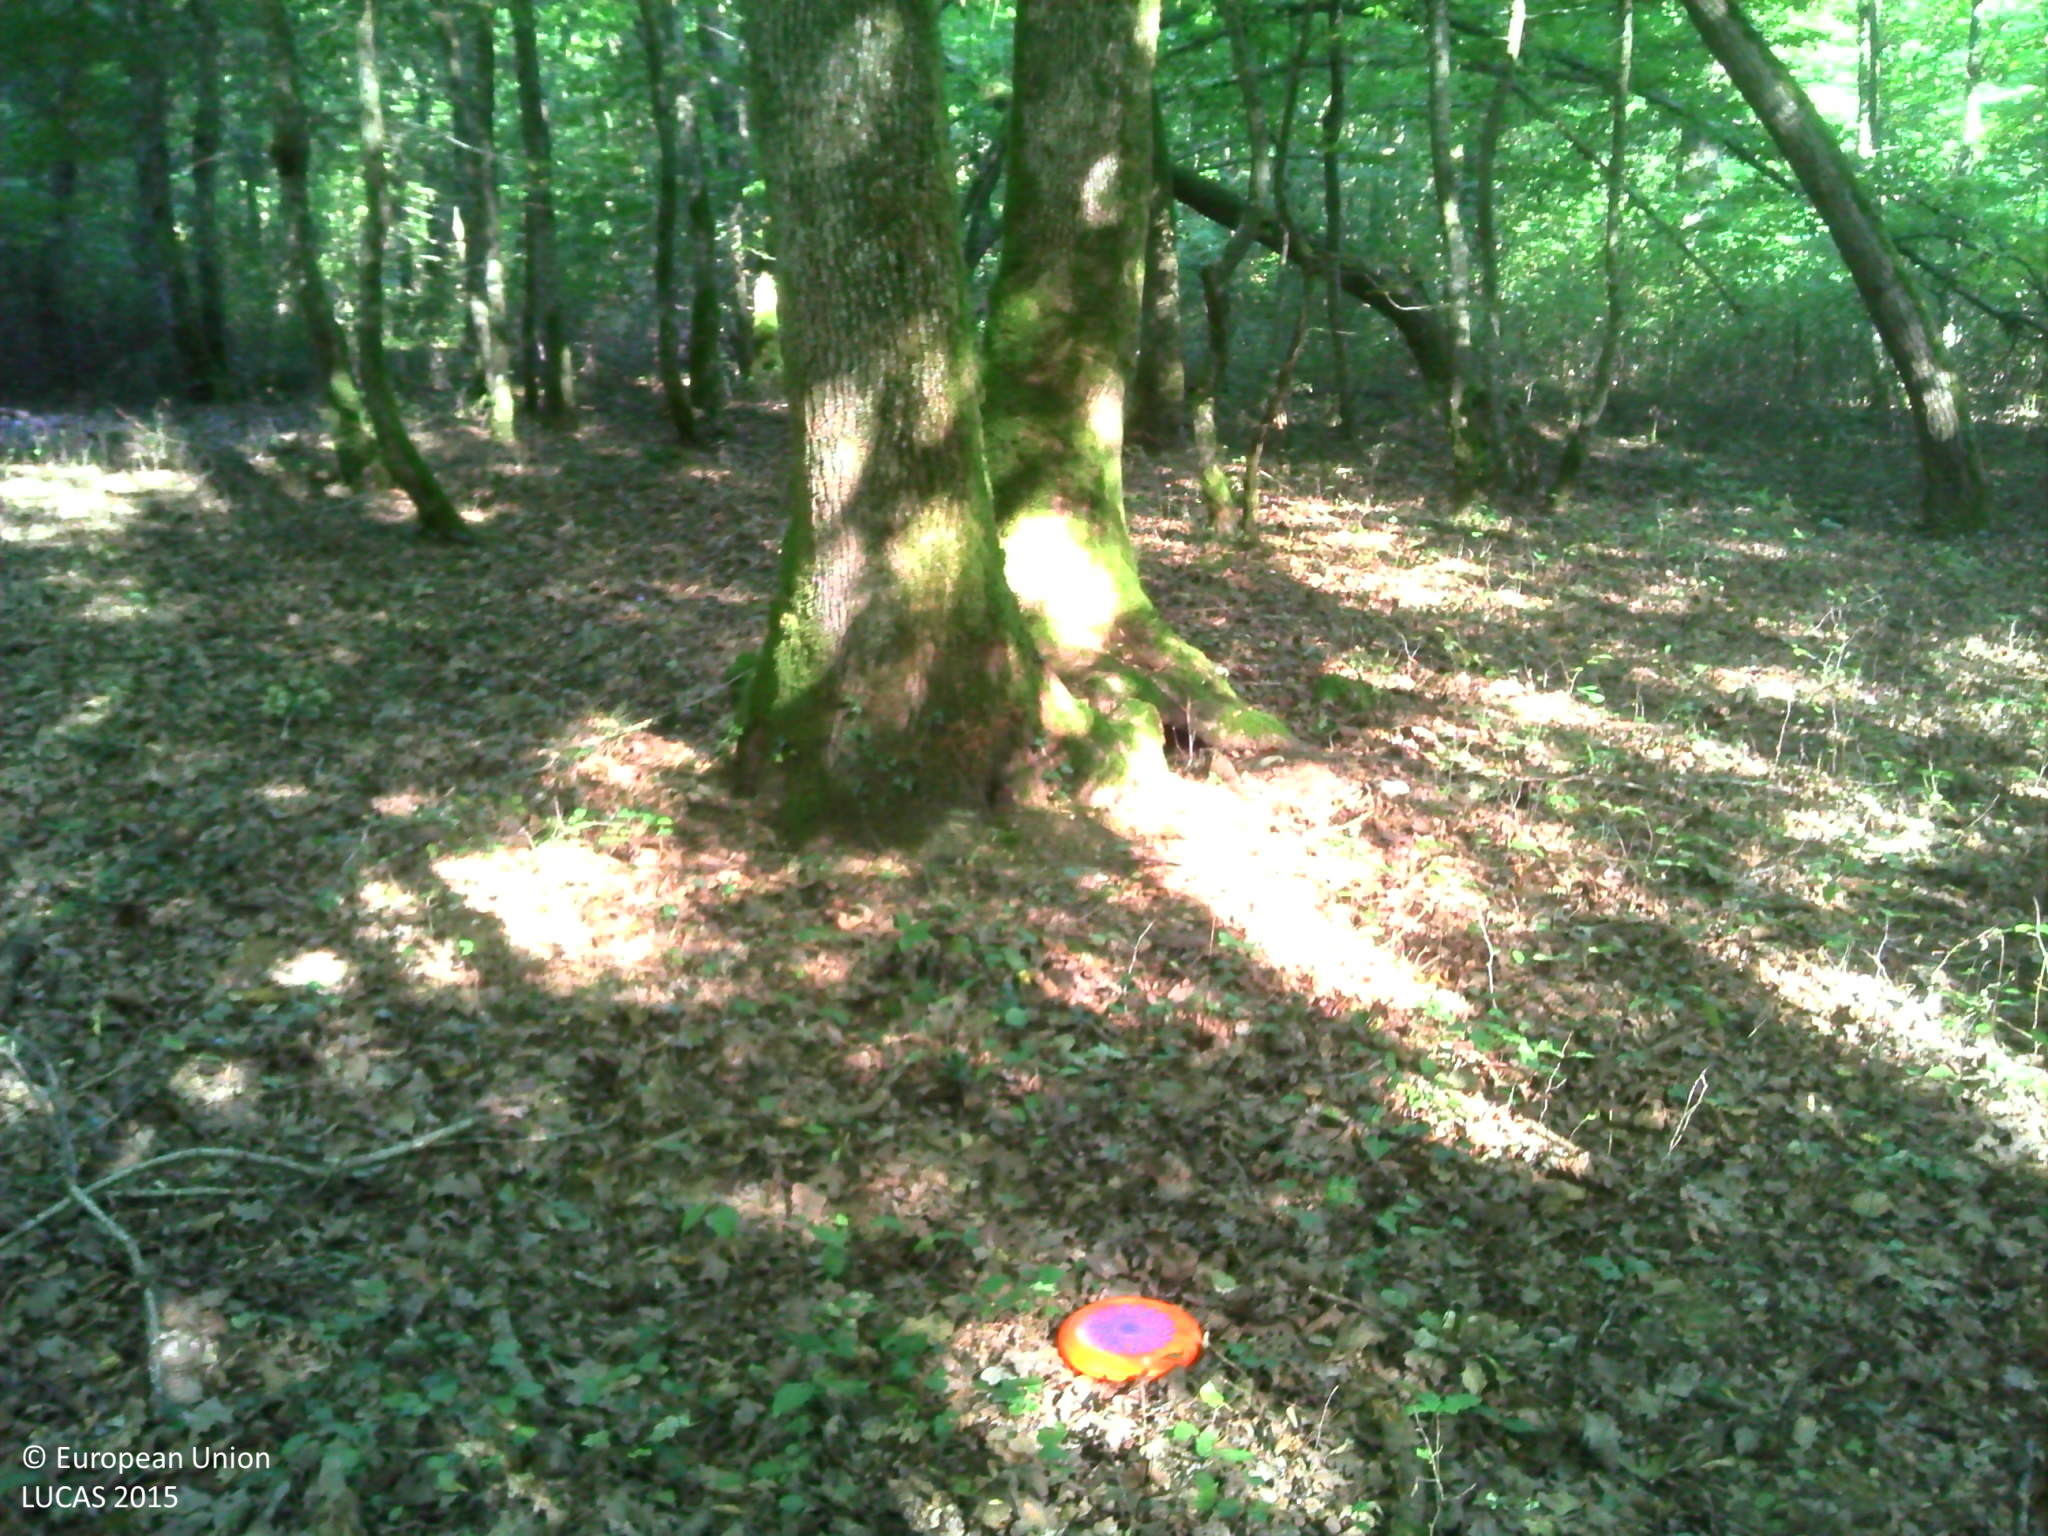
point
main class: Woodland
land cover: Broadleaved woodland
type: mesophytic deciduous forest
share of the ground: > 75 %
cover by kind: broadleaved forest trees 80 %, herbaceous plants 20 %
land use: Semi-natural and natural areas not in use
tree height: > 5 m
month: August
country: FR
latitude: 46.4938
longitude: 4.0723
